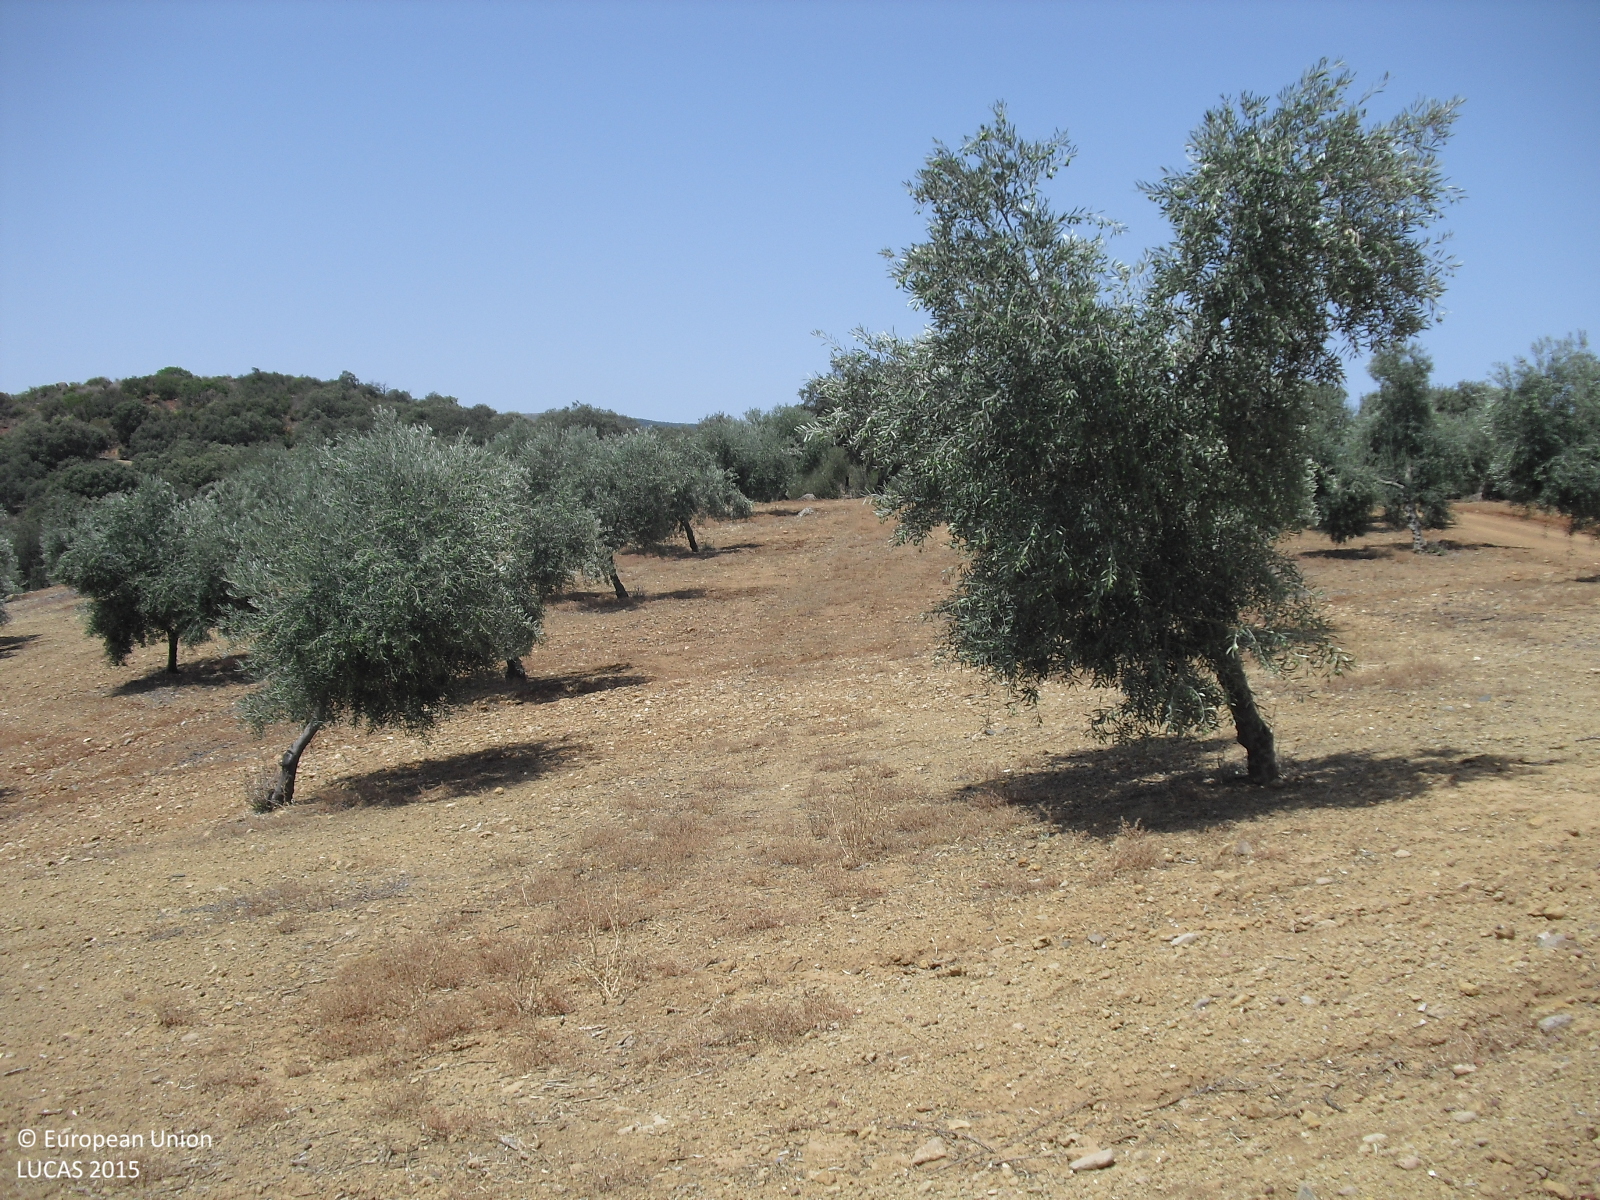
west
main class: Cropland
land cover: Olive groves
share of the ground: 10 - 25 %
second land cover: Other bare soil
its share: > 75 %
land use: Agriculture (excluding fallow land and kitchen gardens)
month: July
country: ES
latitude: 37.1738
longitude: -4.3114
